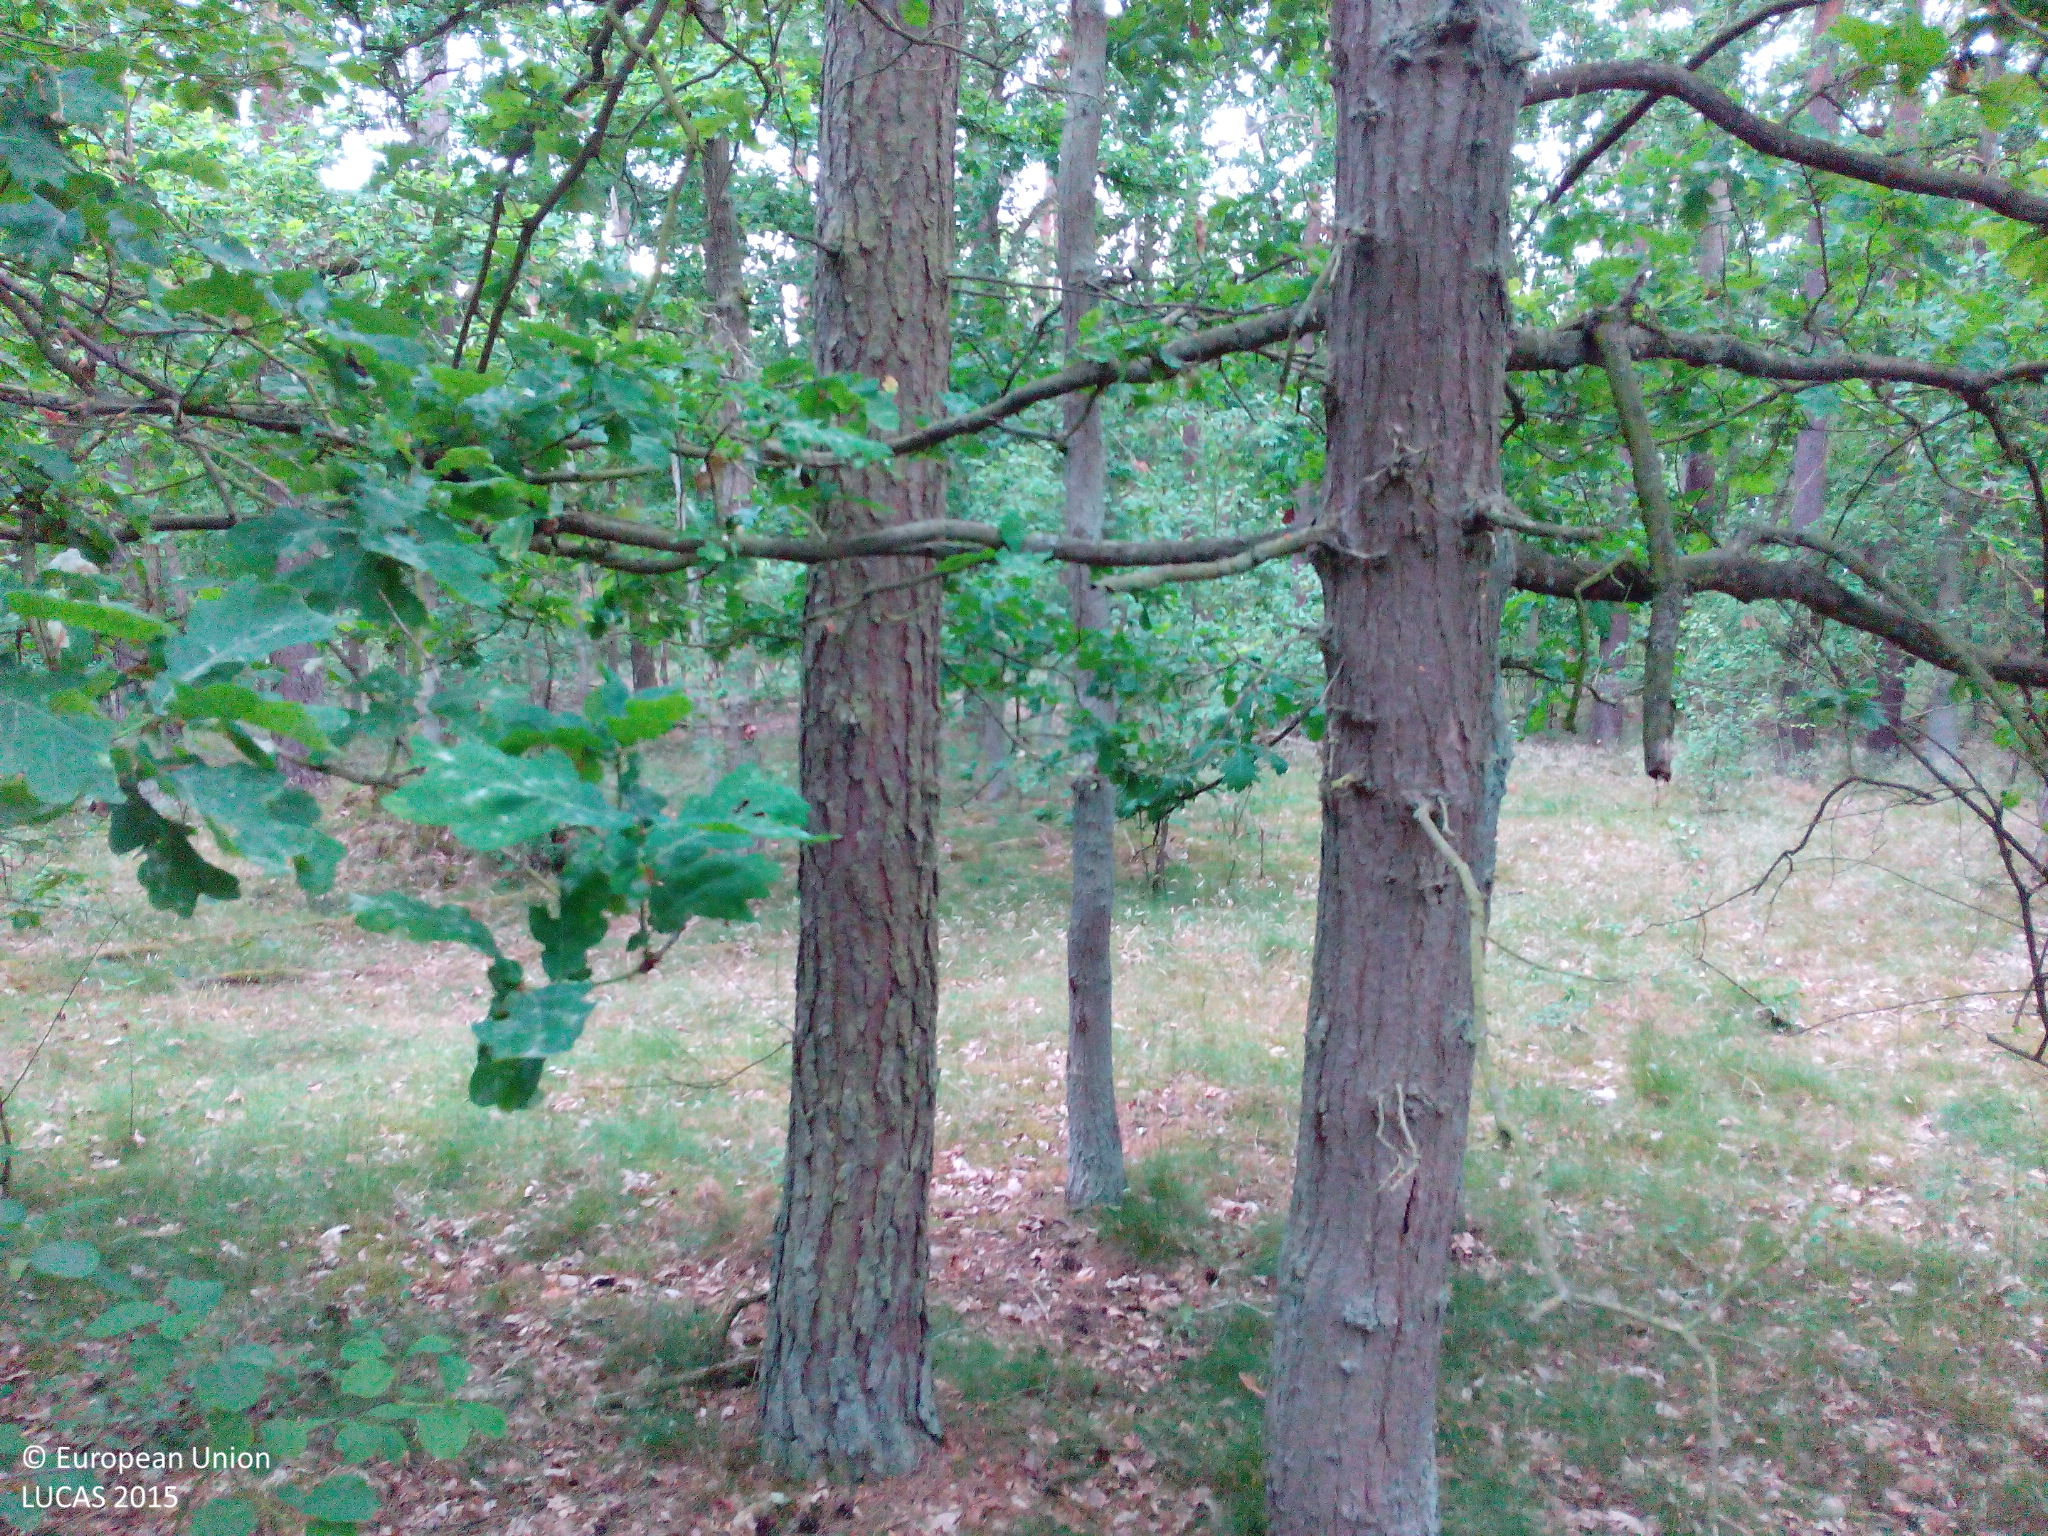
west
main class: Woodland
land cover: Broadleaved woodland
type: mesophytic deciduous forest
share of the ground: > 75 %
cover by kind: broadleaved forest trees 80 %, herbaceous plants 10 %, lichens and mosses 5 %, unconsolidated bare surface 5 %
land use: Forestry
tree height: > 5 m
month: June
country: DE
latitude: 53.1915
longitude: 11.7505
